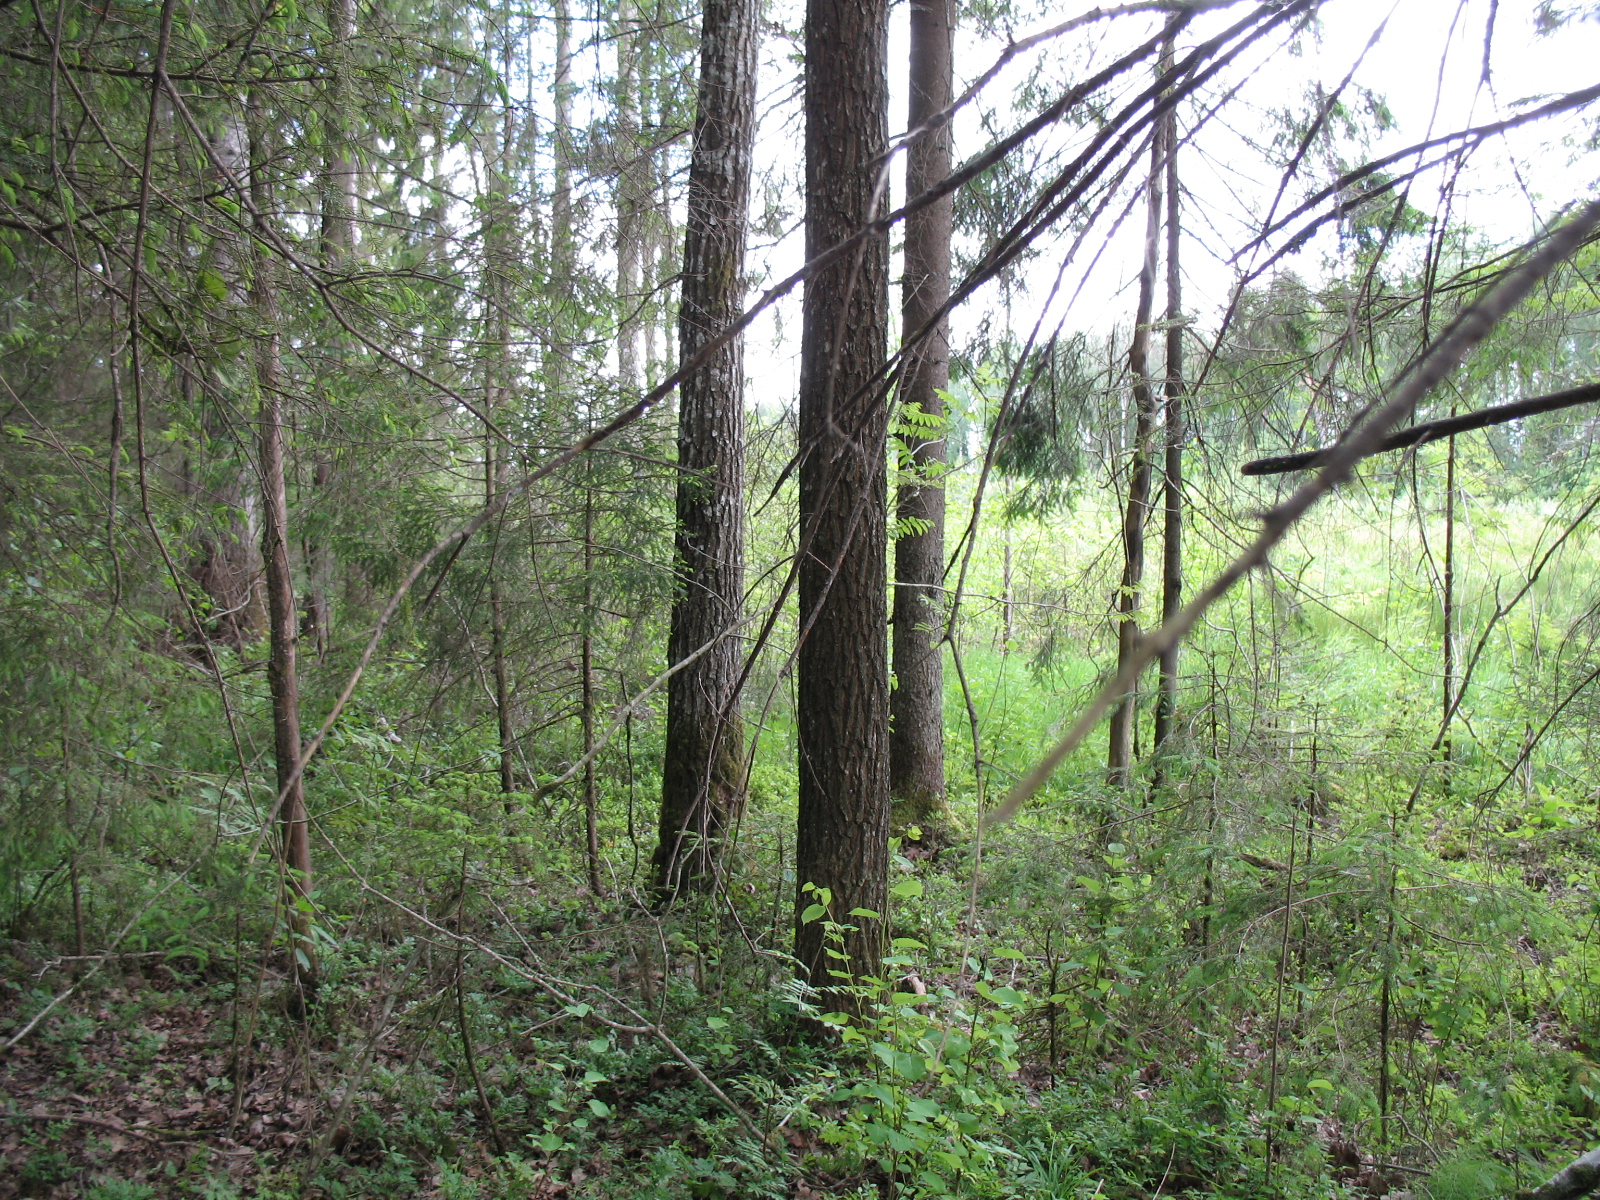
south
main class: Woodland
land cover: Spruce dominated mixed woodland
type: hemiboreal forest and nemoral coniferous forest and mixed broadleaved-coniferous forest
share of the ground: > 75 %
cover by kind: broadleaved forest trees 60 %, coniferous forest trees 35 %, shrubs 5 %
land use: Forestry
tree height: > 5 m
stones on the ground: < 10 %
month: June
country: LV
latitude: 56.6746
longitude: 23.5062
